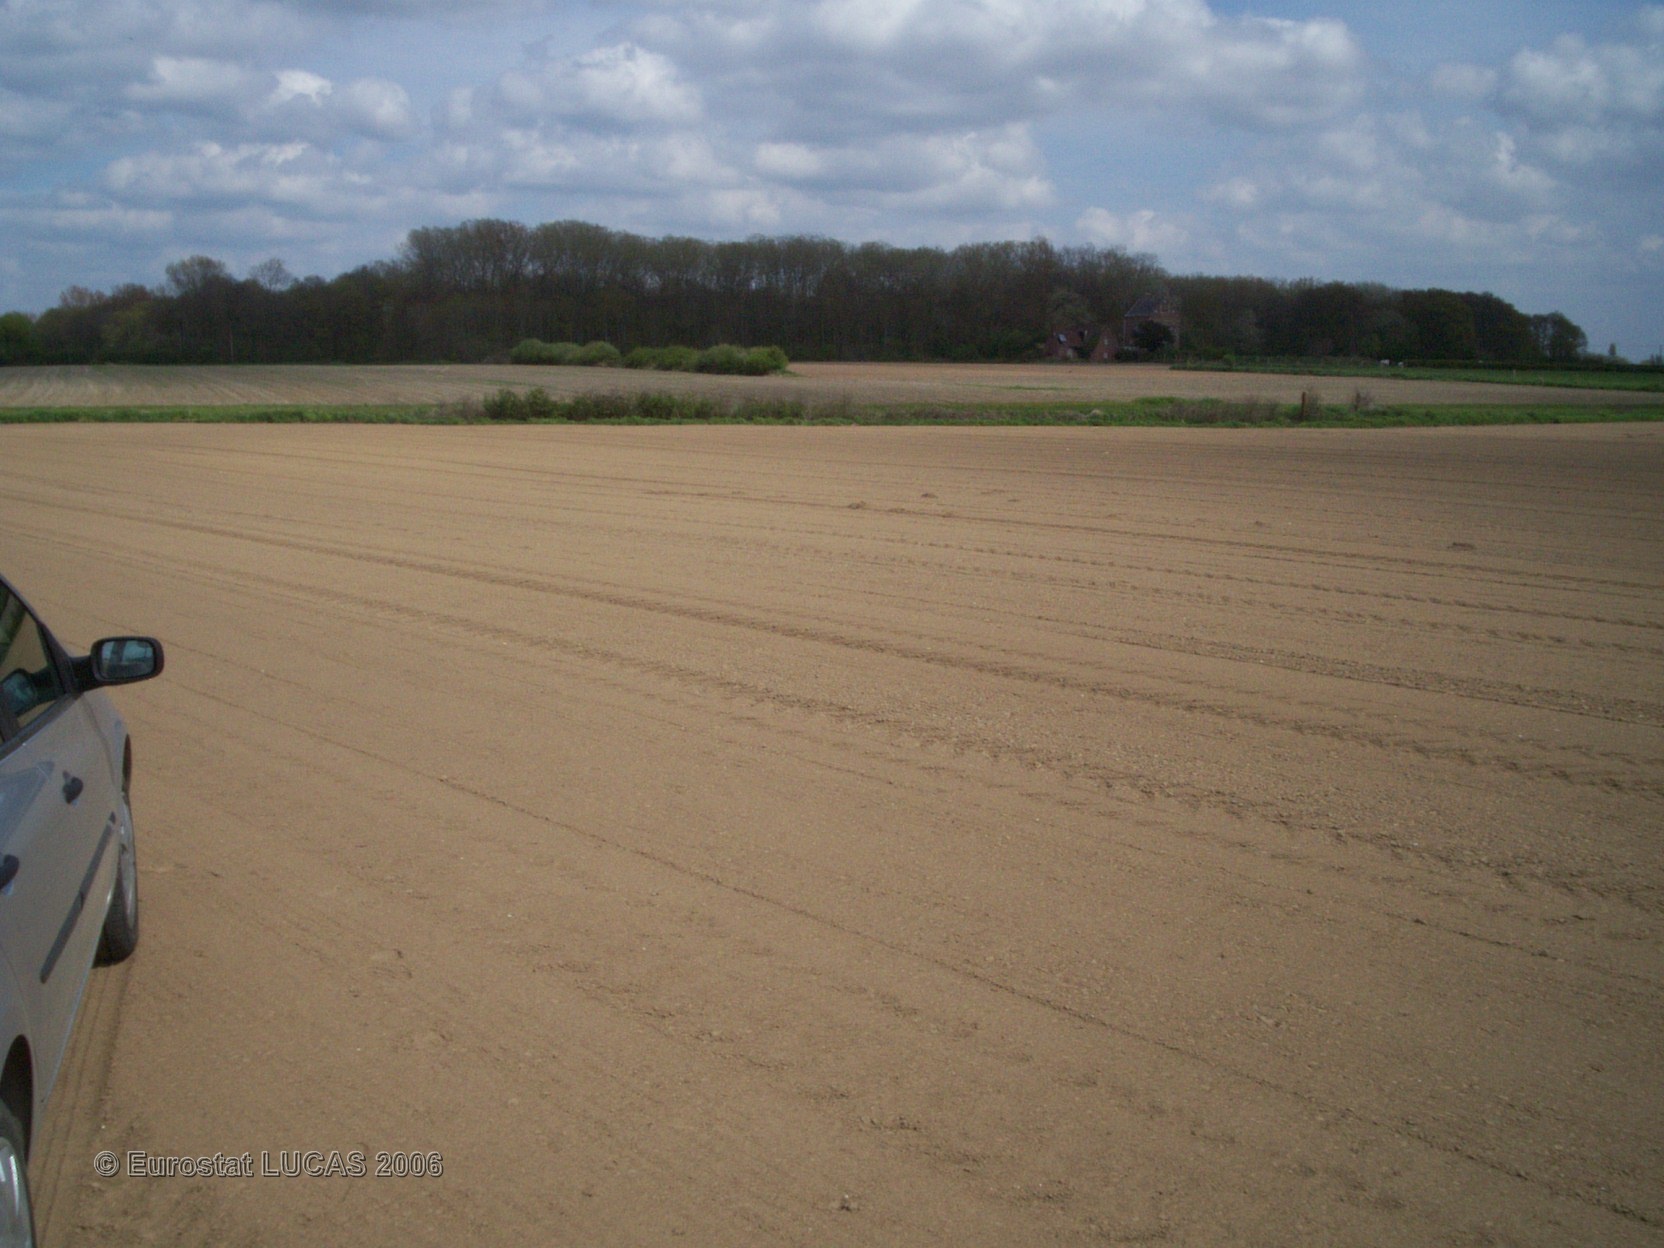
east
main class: Cropland
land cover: Other fresh vegetables
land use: Agriculture (excluding fallow land and kitchen gardens)
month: June
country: FR
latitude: 50.8618
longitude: 2.5571
